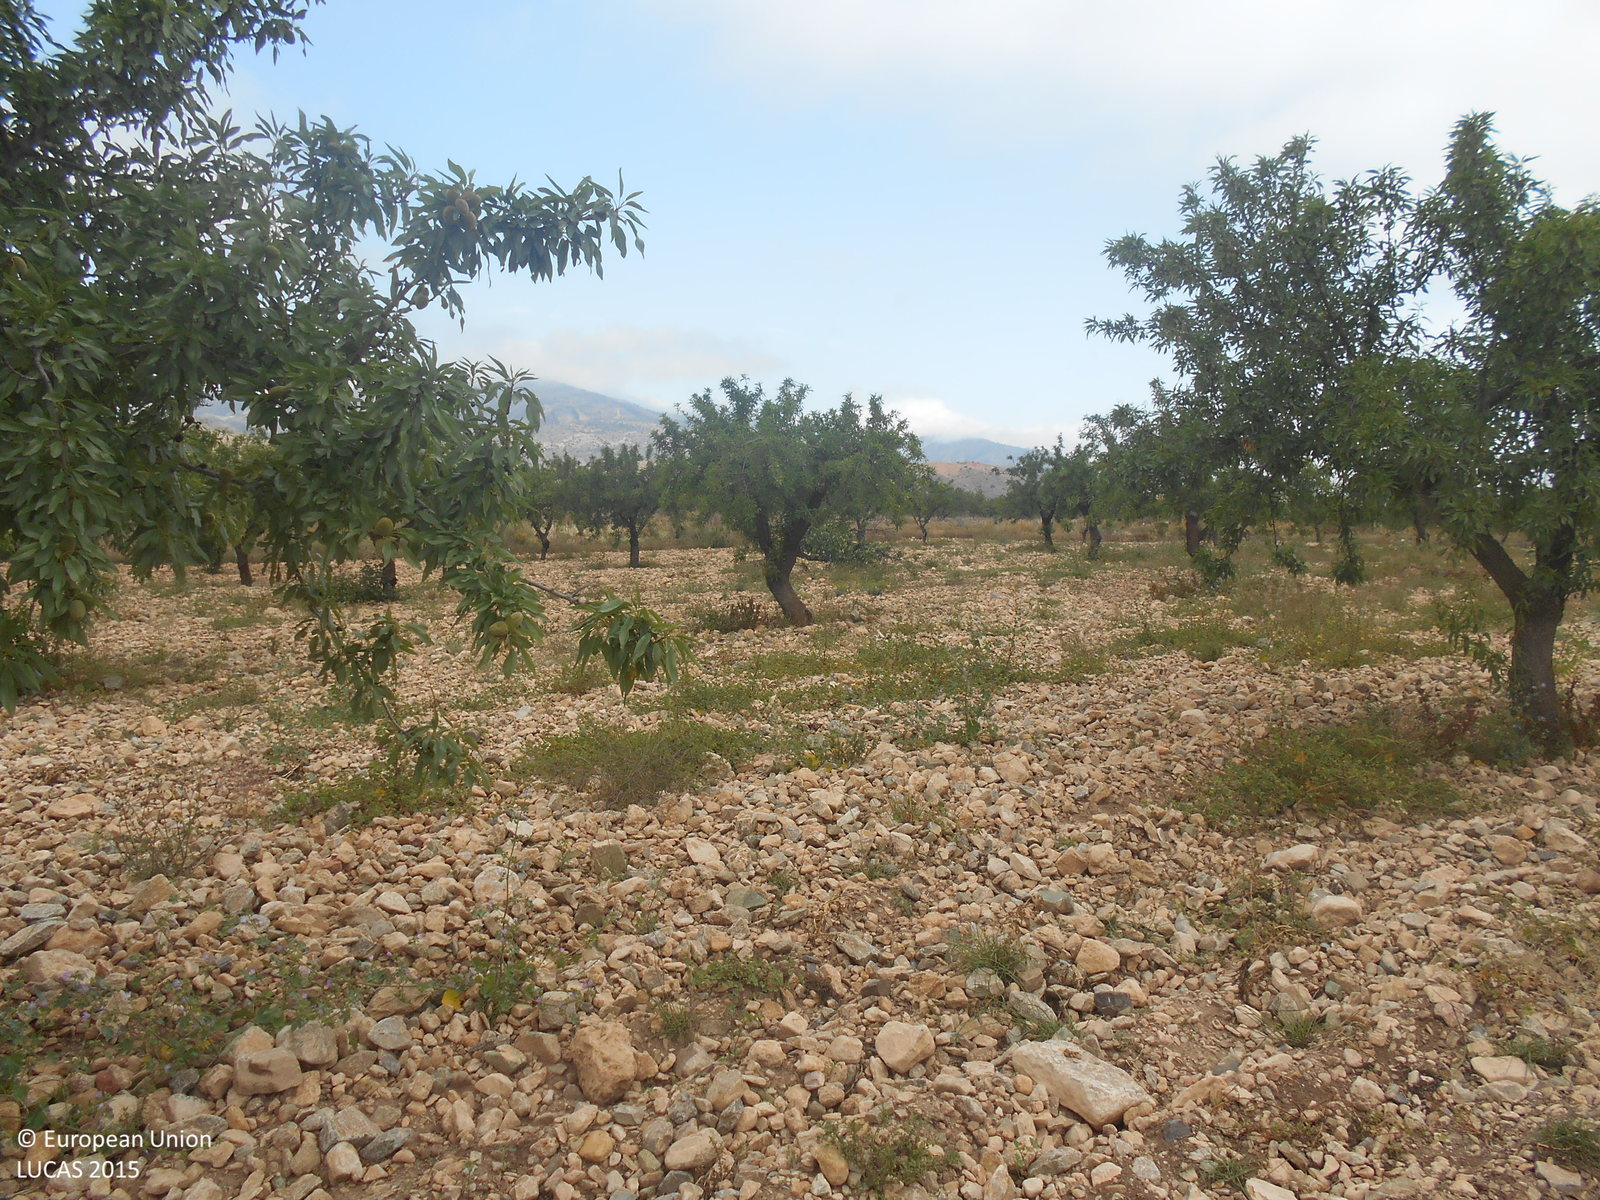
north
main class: Cropland
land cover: Nuts trees
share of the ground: 25 - 50 %
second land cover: Other bare soil
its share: > 75 %
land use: Agriculture (excluding fallow land and kitchen gardens)
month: April
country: ES
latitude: 37.7902
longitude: -1.2581
